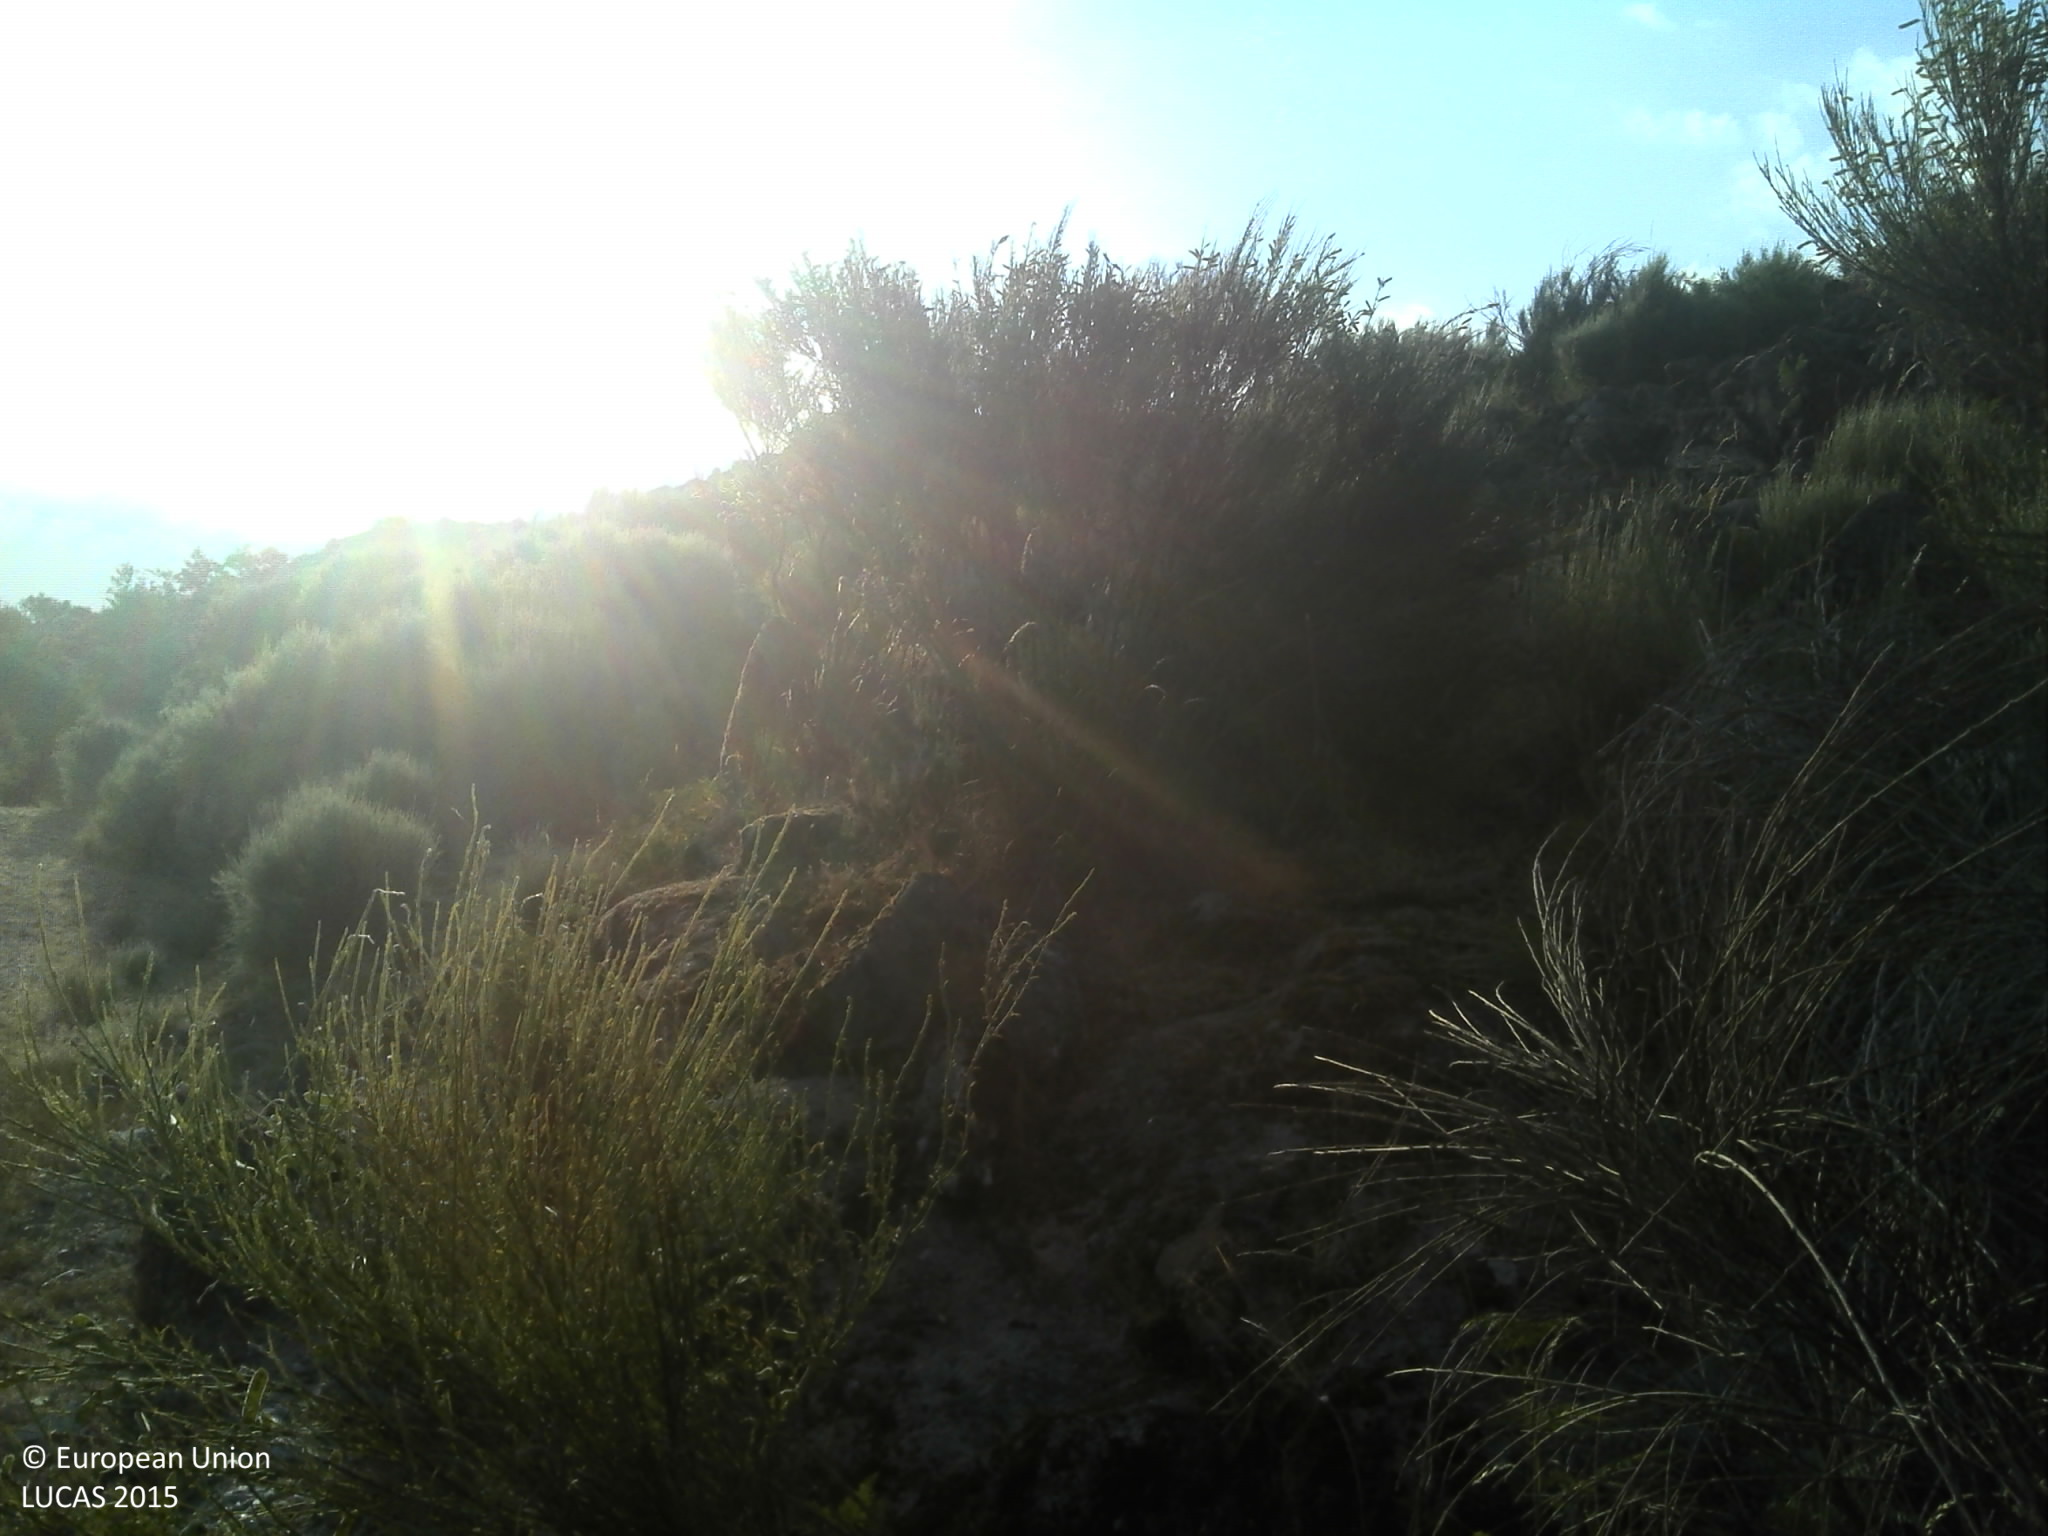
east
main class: Shrubland
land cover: Shrubland without tree cover
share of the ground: 25 - 50 %
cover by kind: shrubs 40 %, unconsolidated bare surface 20 %, herbaceous plants 15 %, consolidated bare surface 15 %
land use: Semi-natural and natural areas not in use
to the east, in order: Shrubland without tree cover; Shrubland with sparse tree cover; Rocks and stones; Shrubland with sparse tree cover
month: June
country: PT
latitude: 40.3784
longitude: -7.1920
